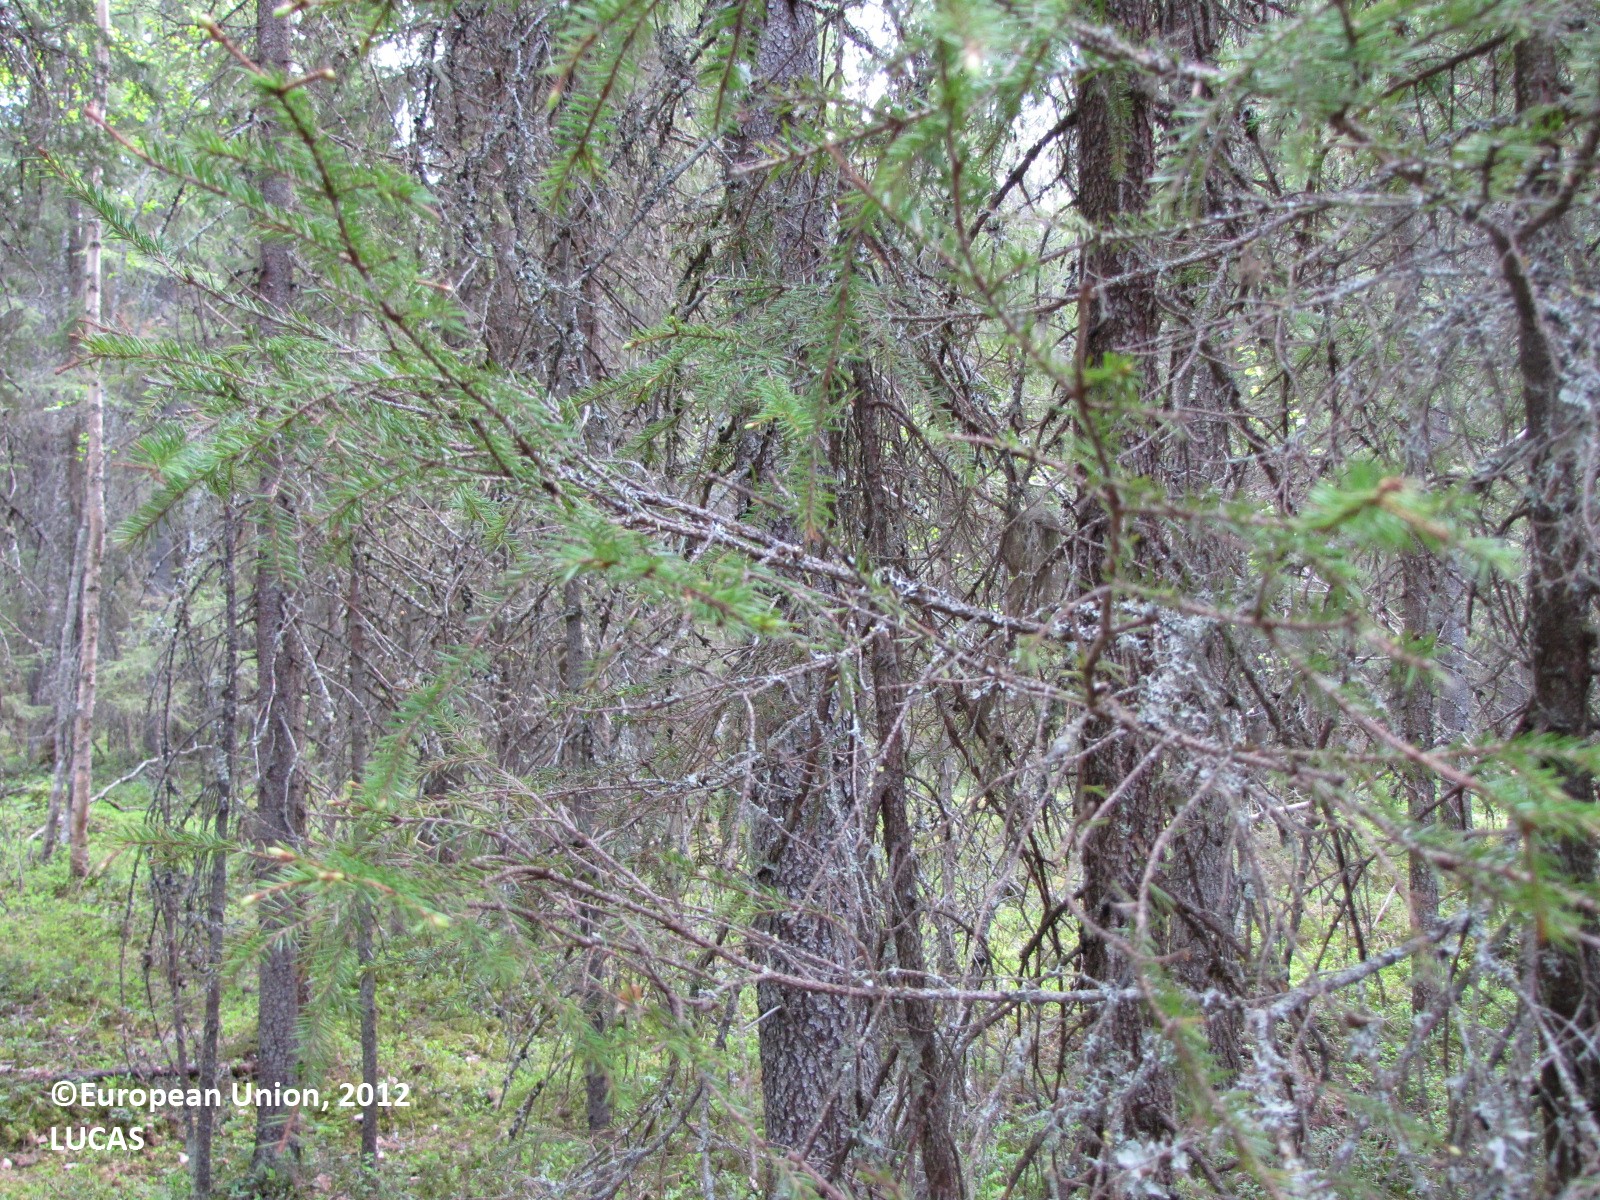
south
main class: Woodland
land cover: Spruce dominated coniferous woodland
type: boreal forest
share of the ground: 50 - 75 %
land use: Forestry
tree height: > 5 m
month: June
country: FI
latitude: 65.9908
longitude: 24.5672
